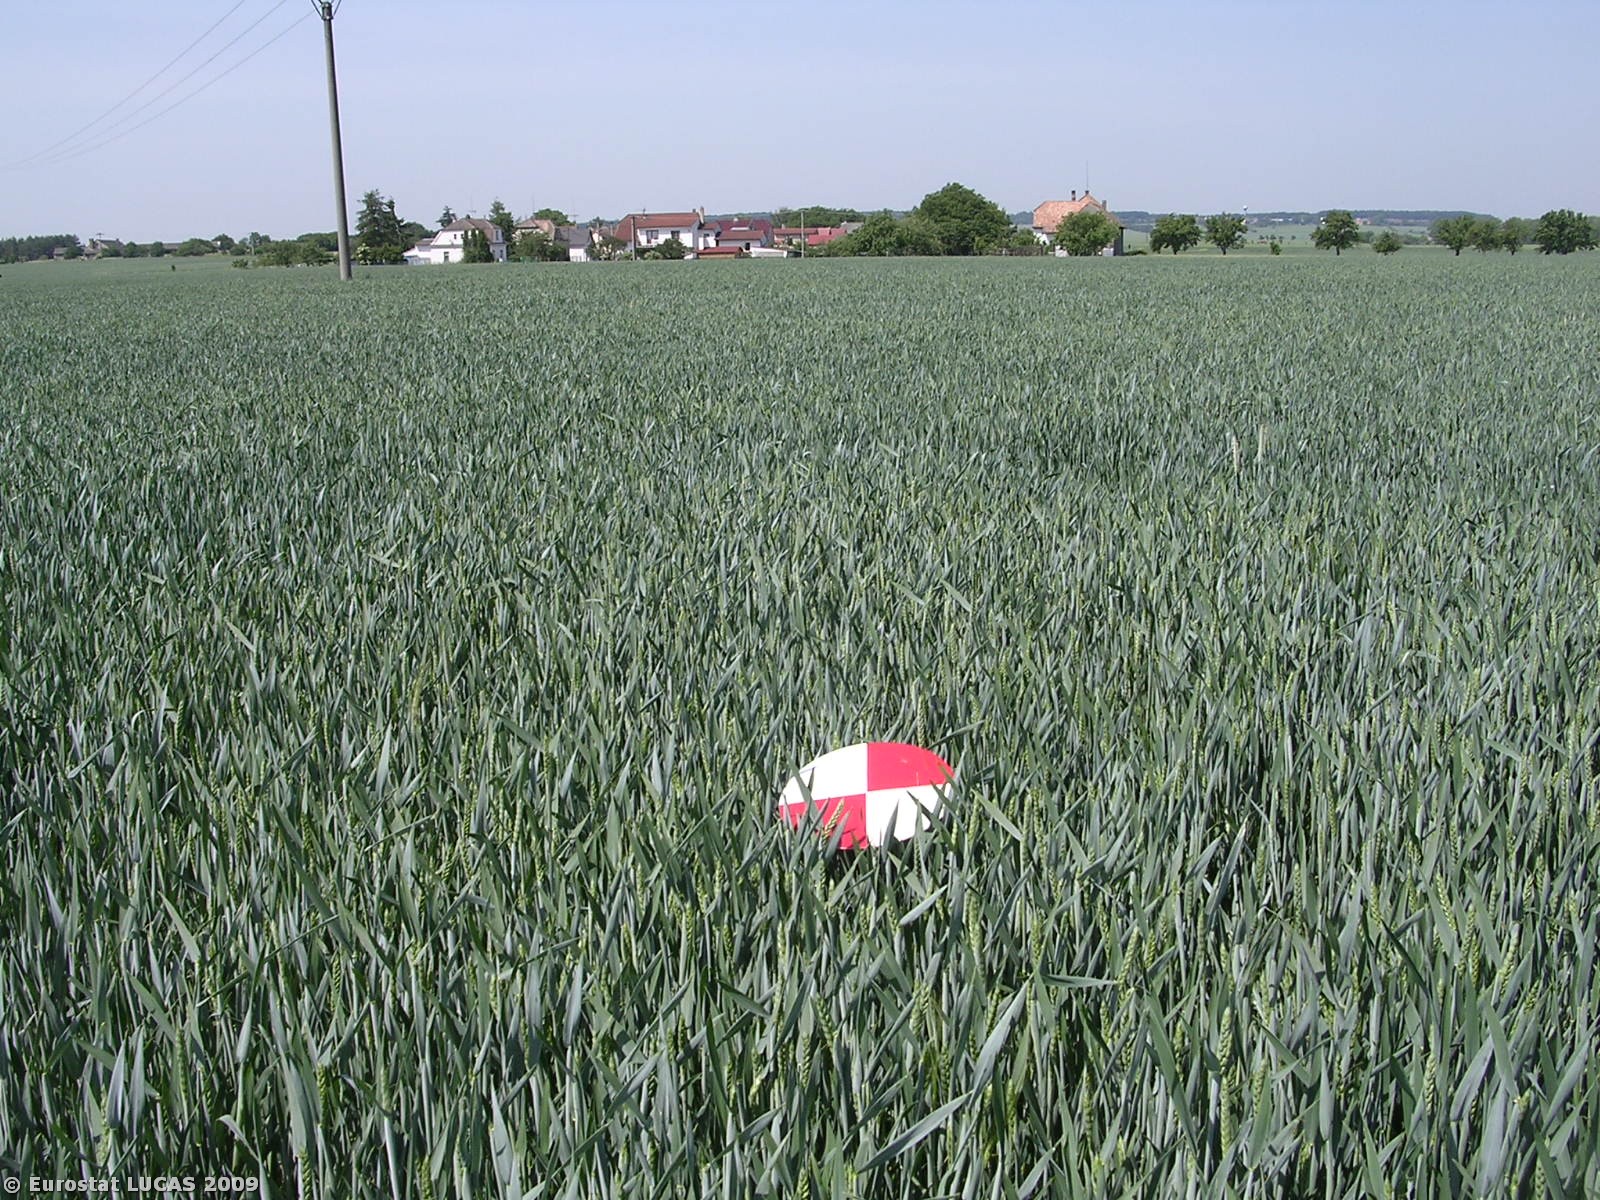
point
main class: Cropland
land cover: Common wheat
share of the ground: > 75 %
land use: Agriculture (excluding fallow land and kitchen gardens)
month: May
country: CZ
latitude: 50.3477
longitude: 14.9353
